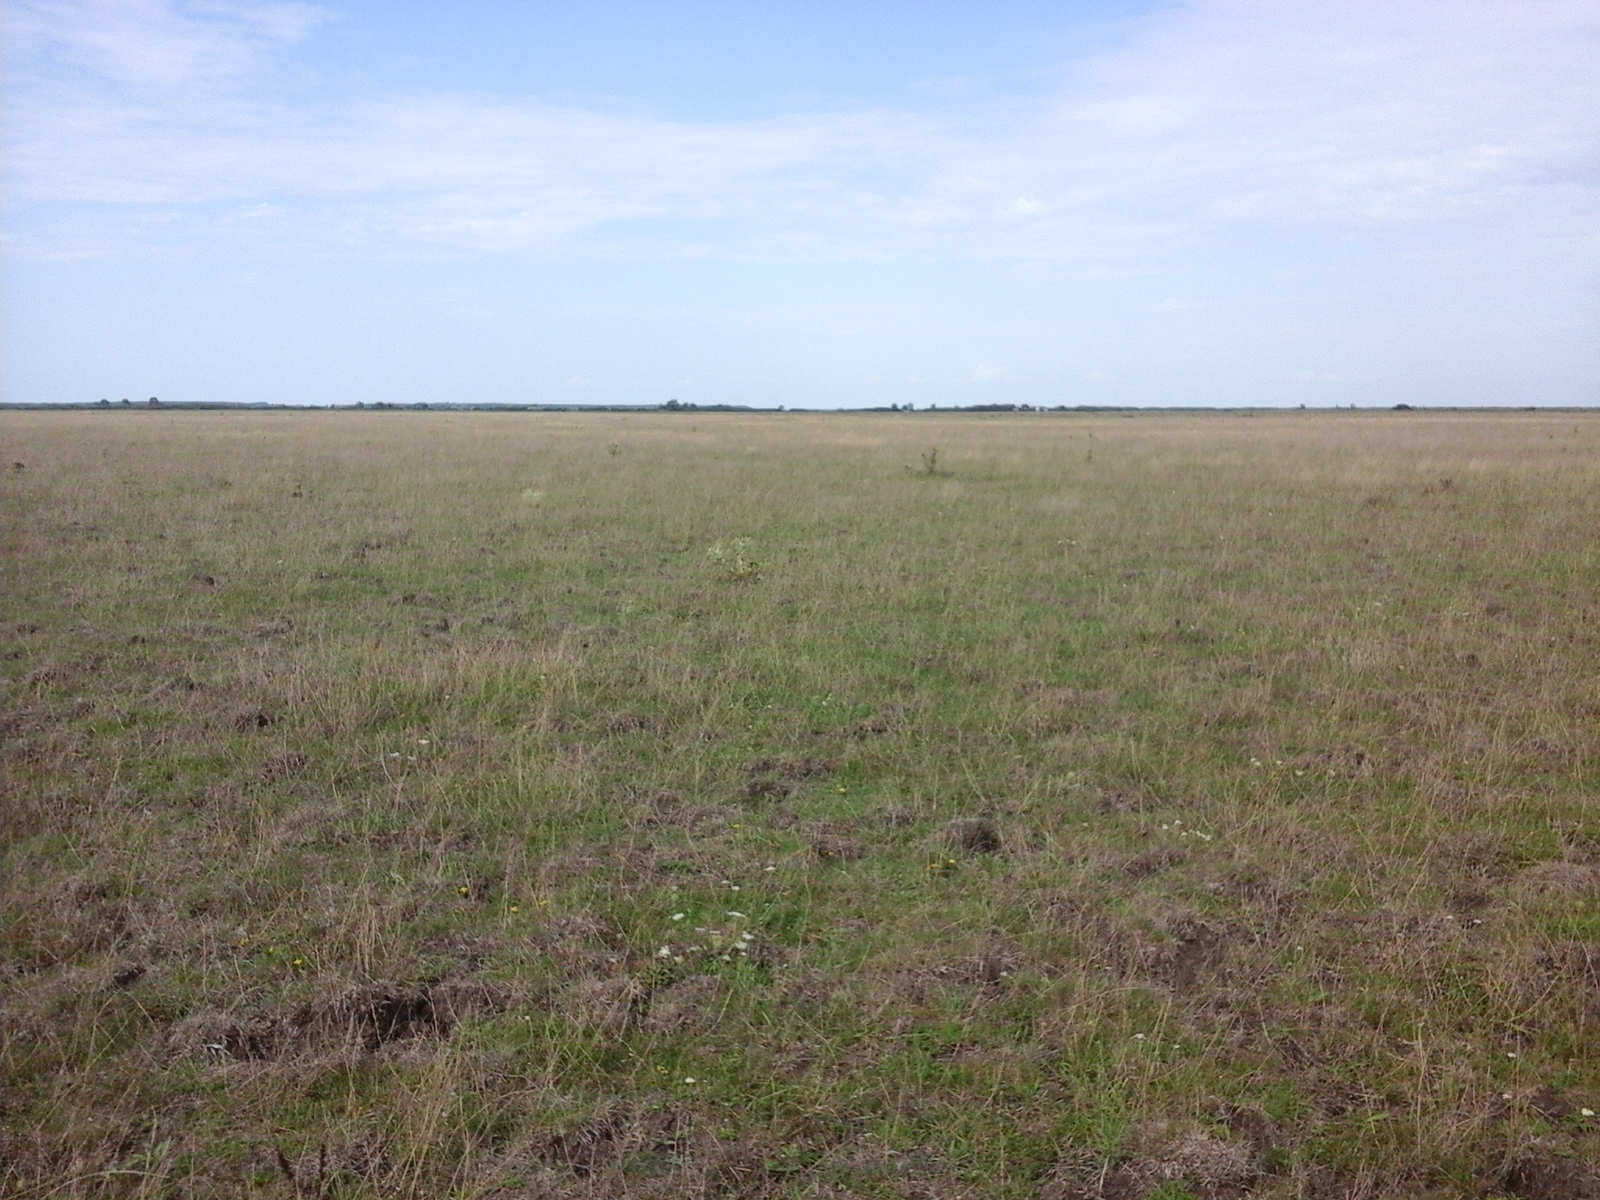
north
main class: Grassland
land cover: Grassland without tree/shrub cover
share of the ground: > 75 %
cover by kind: herbaceous plants 100 %
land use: Agriculture (excluding fallow land and kitchen gardens)
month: August
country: RO
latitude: 46.6084
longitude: 21.4356
